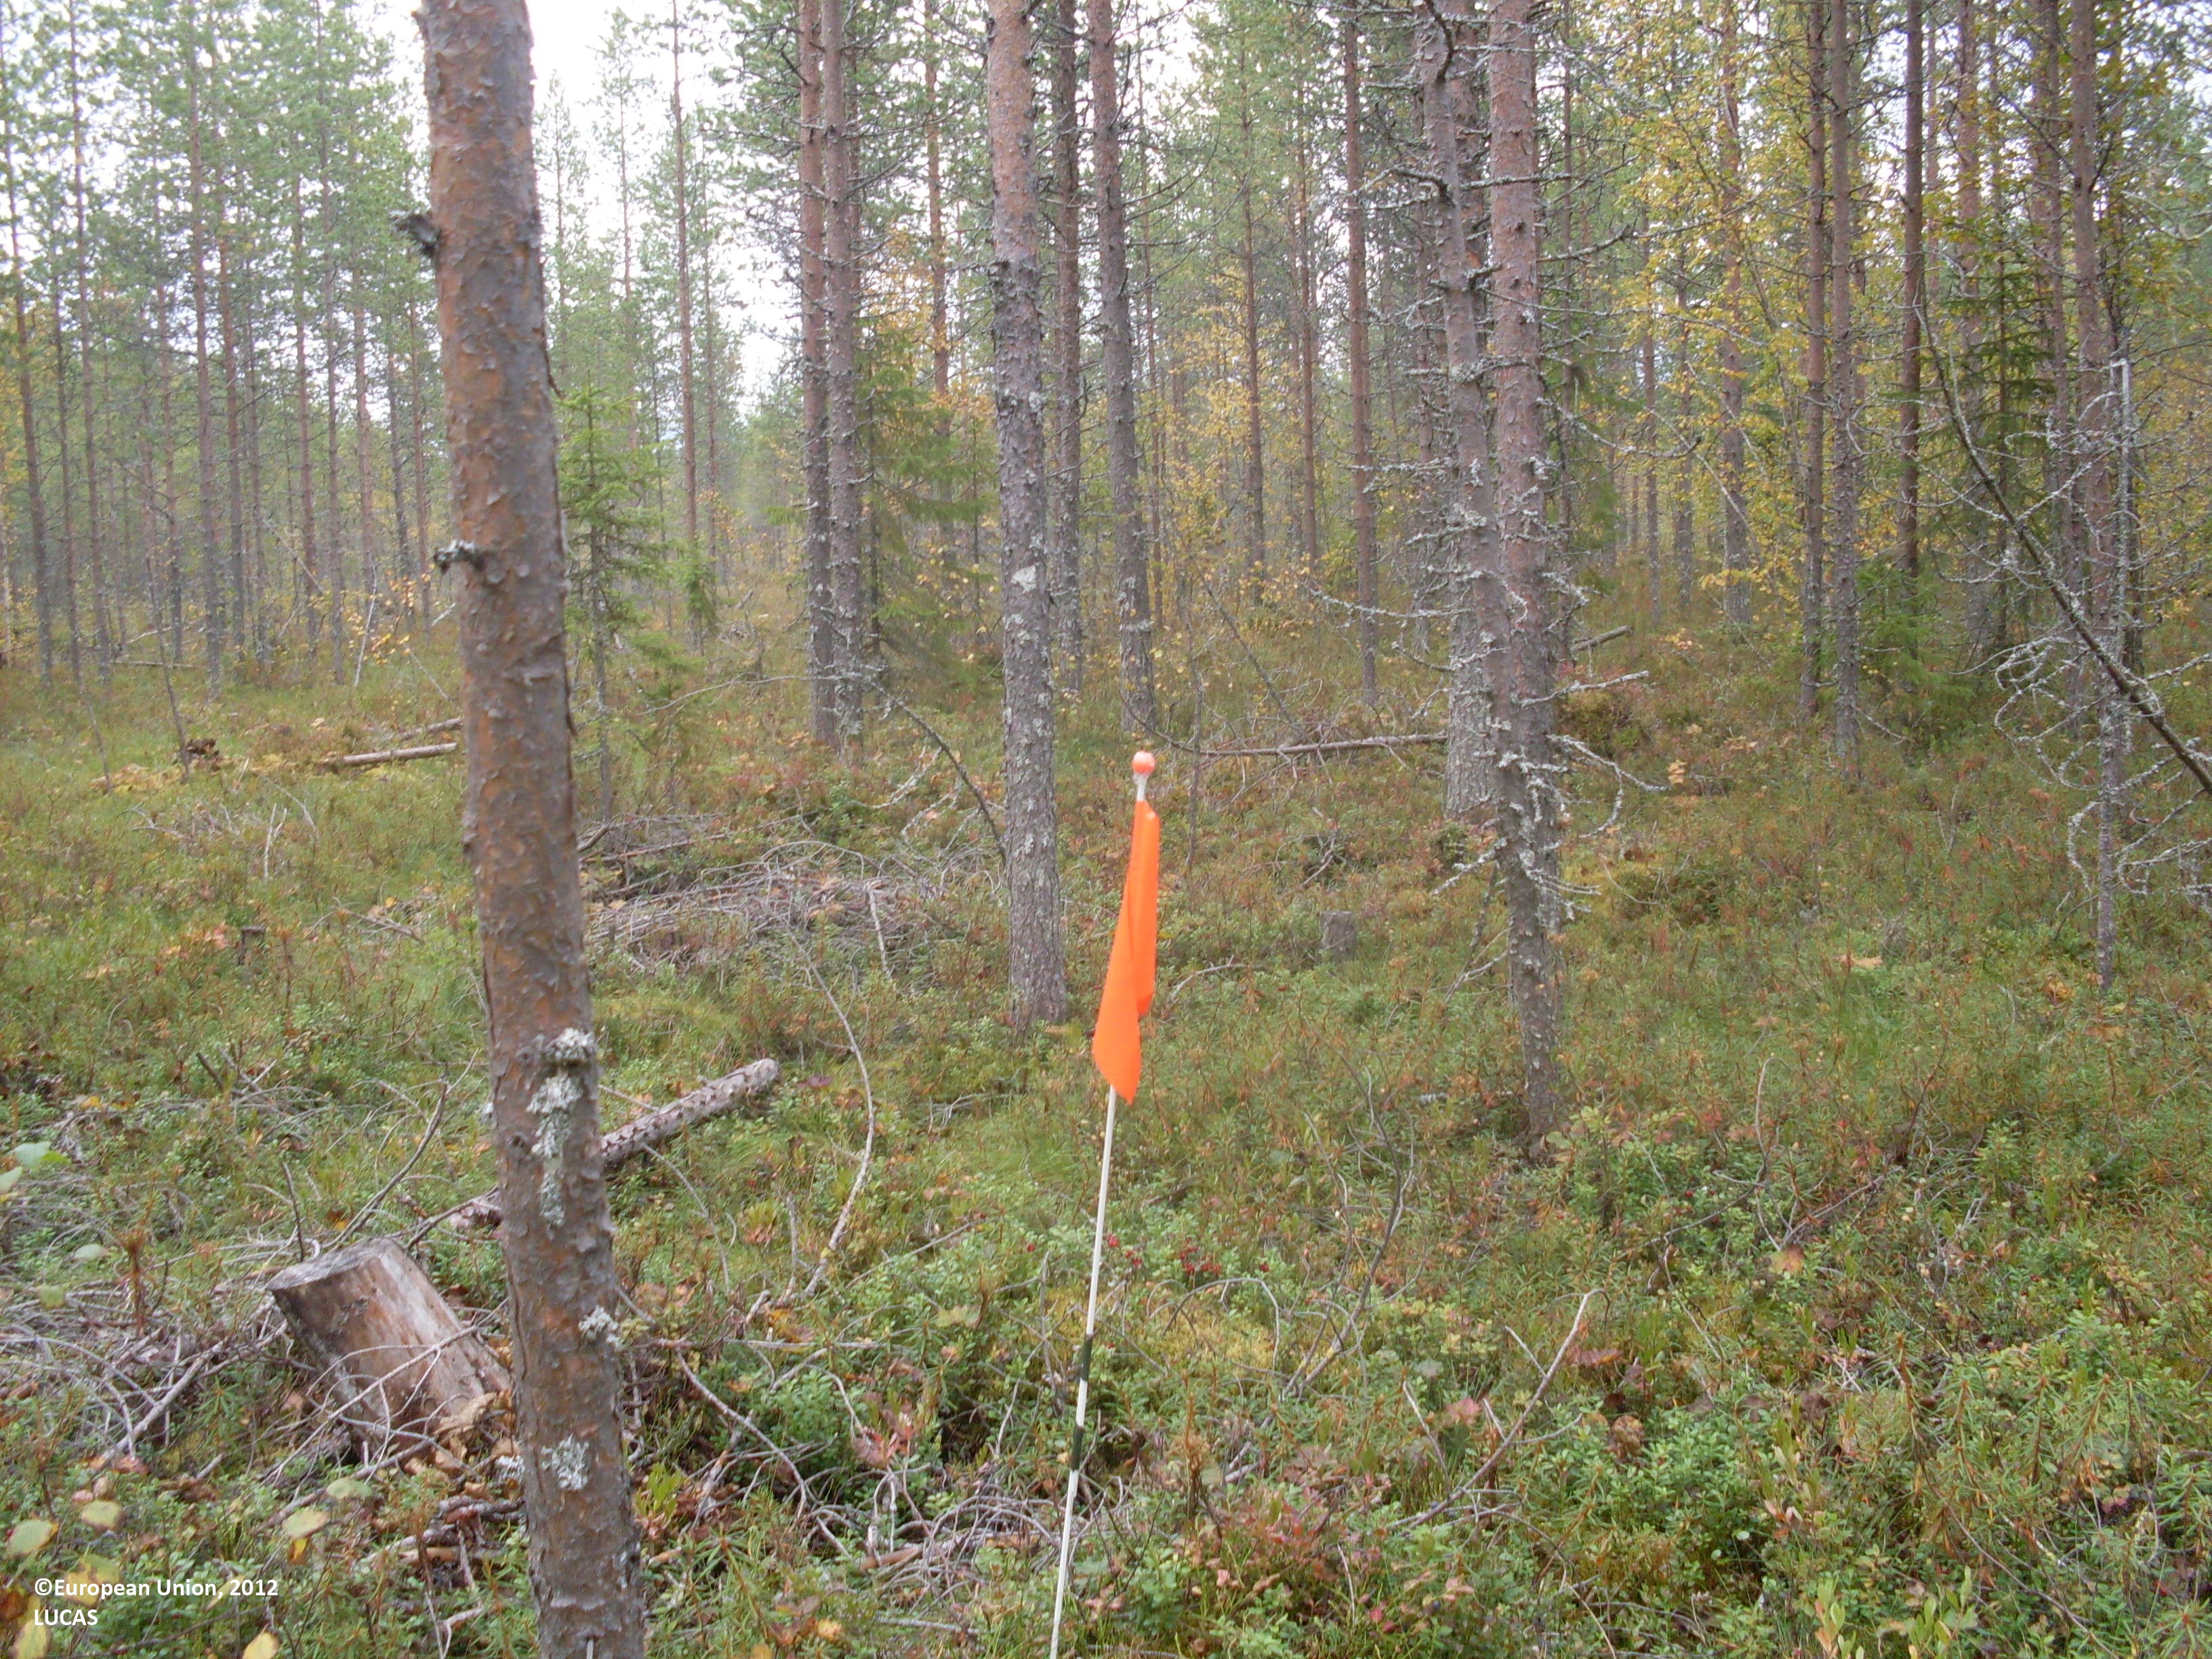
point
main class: Woodland
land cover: Pine dominated coniferous woodland
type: boreal forest
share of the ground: > 75 %
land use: Forestry
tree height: > 5 m
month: September
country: FI
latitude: 64.0416
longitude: 29.7010
